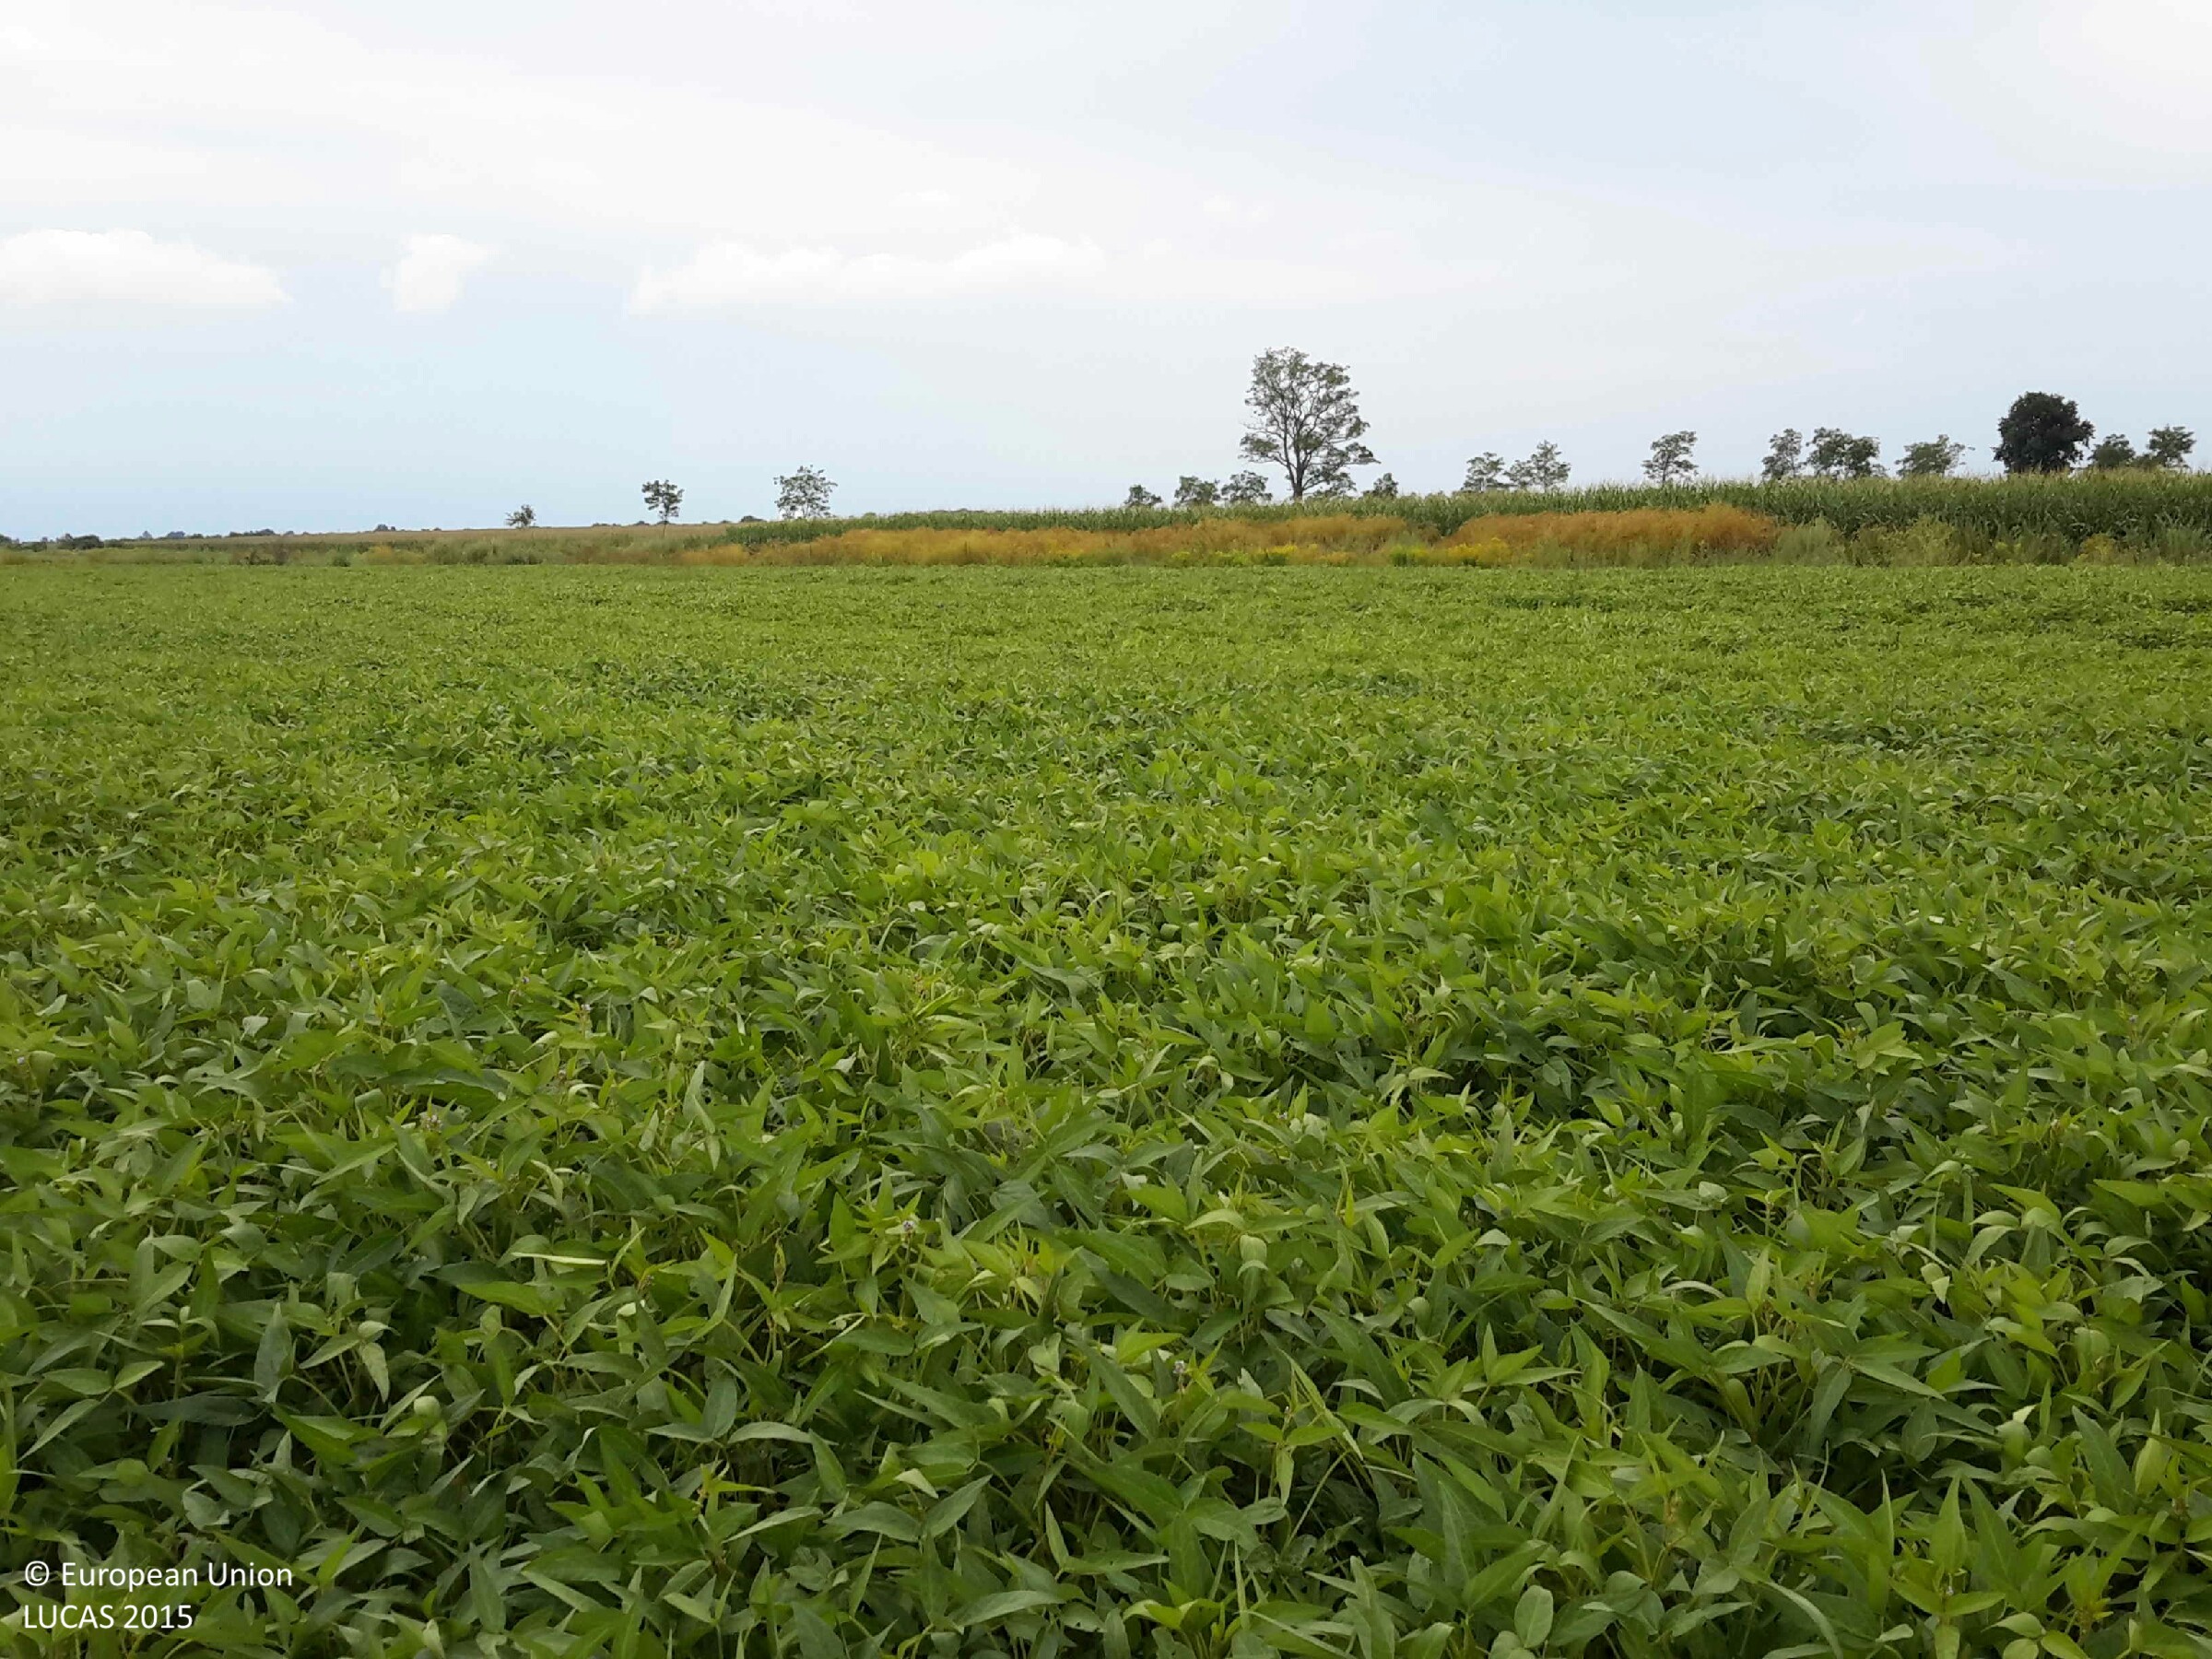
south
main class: Cropland
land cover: Soya
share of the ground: > 75 %
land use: Agriculture (excluding fallow land and kitchen gardens)
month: July
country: HU
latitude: 47.3195
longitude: 16.6321
